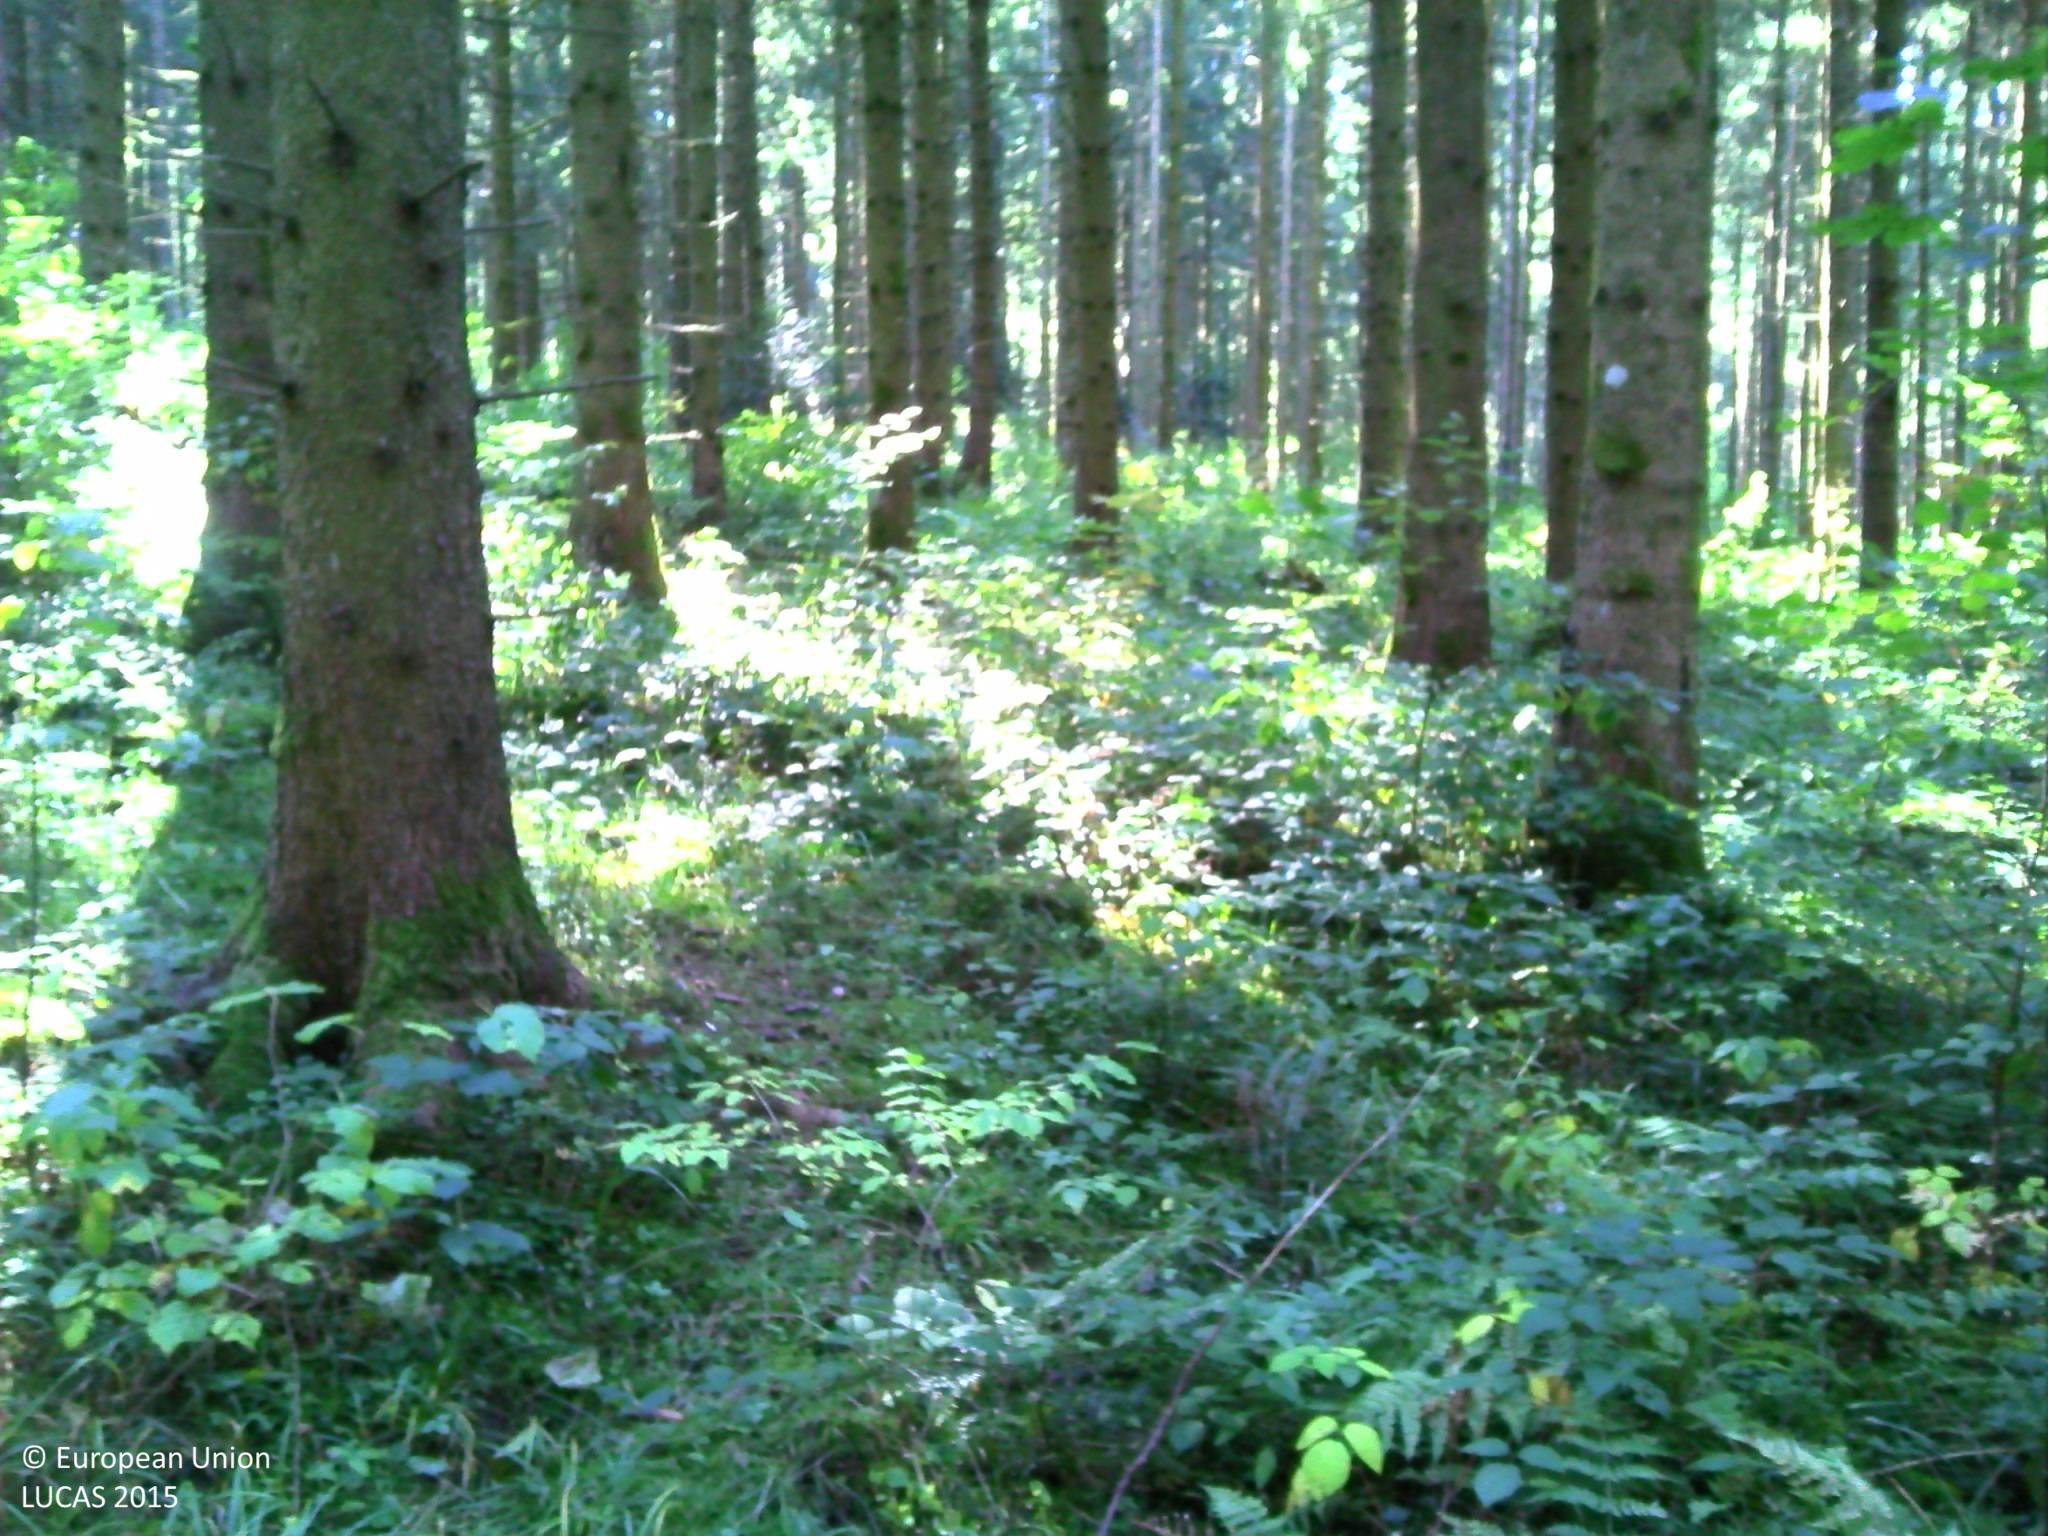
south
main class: Woodland
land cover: Spruce dominated coniferous woodland
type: exotic forest
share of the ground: > 75 %
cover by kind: coniferous forest trees 90 %, shrubs 5 %, herbaceous plants 5 %
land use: Forestry
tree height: > 5 m
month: September
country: FR
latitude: 47.1878
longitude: 6.8479
